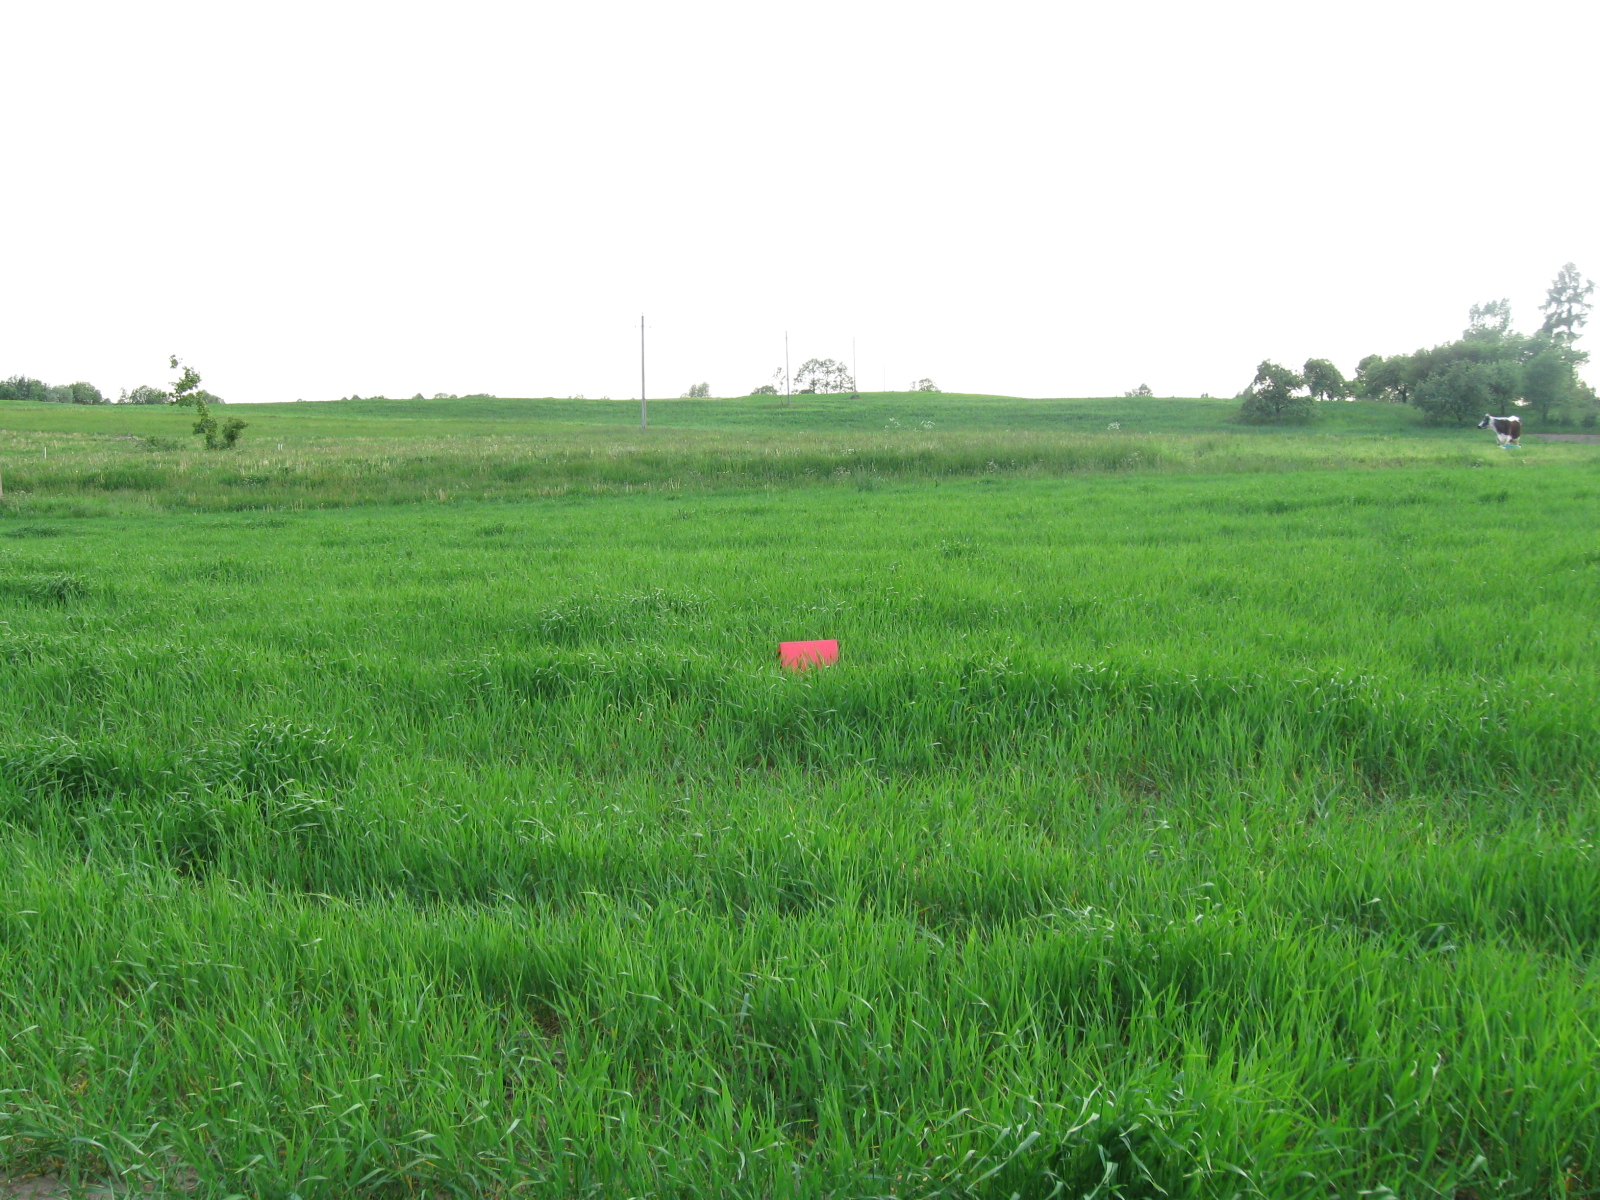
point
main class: Cropland
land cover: Barley
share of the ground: > 75 %
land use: Agriculture (excluding fallow land and kitchen gardens)
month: June
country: LT
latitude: 54.2675
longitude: 23.6431
